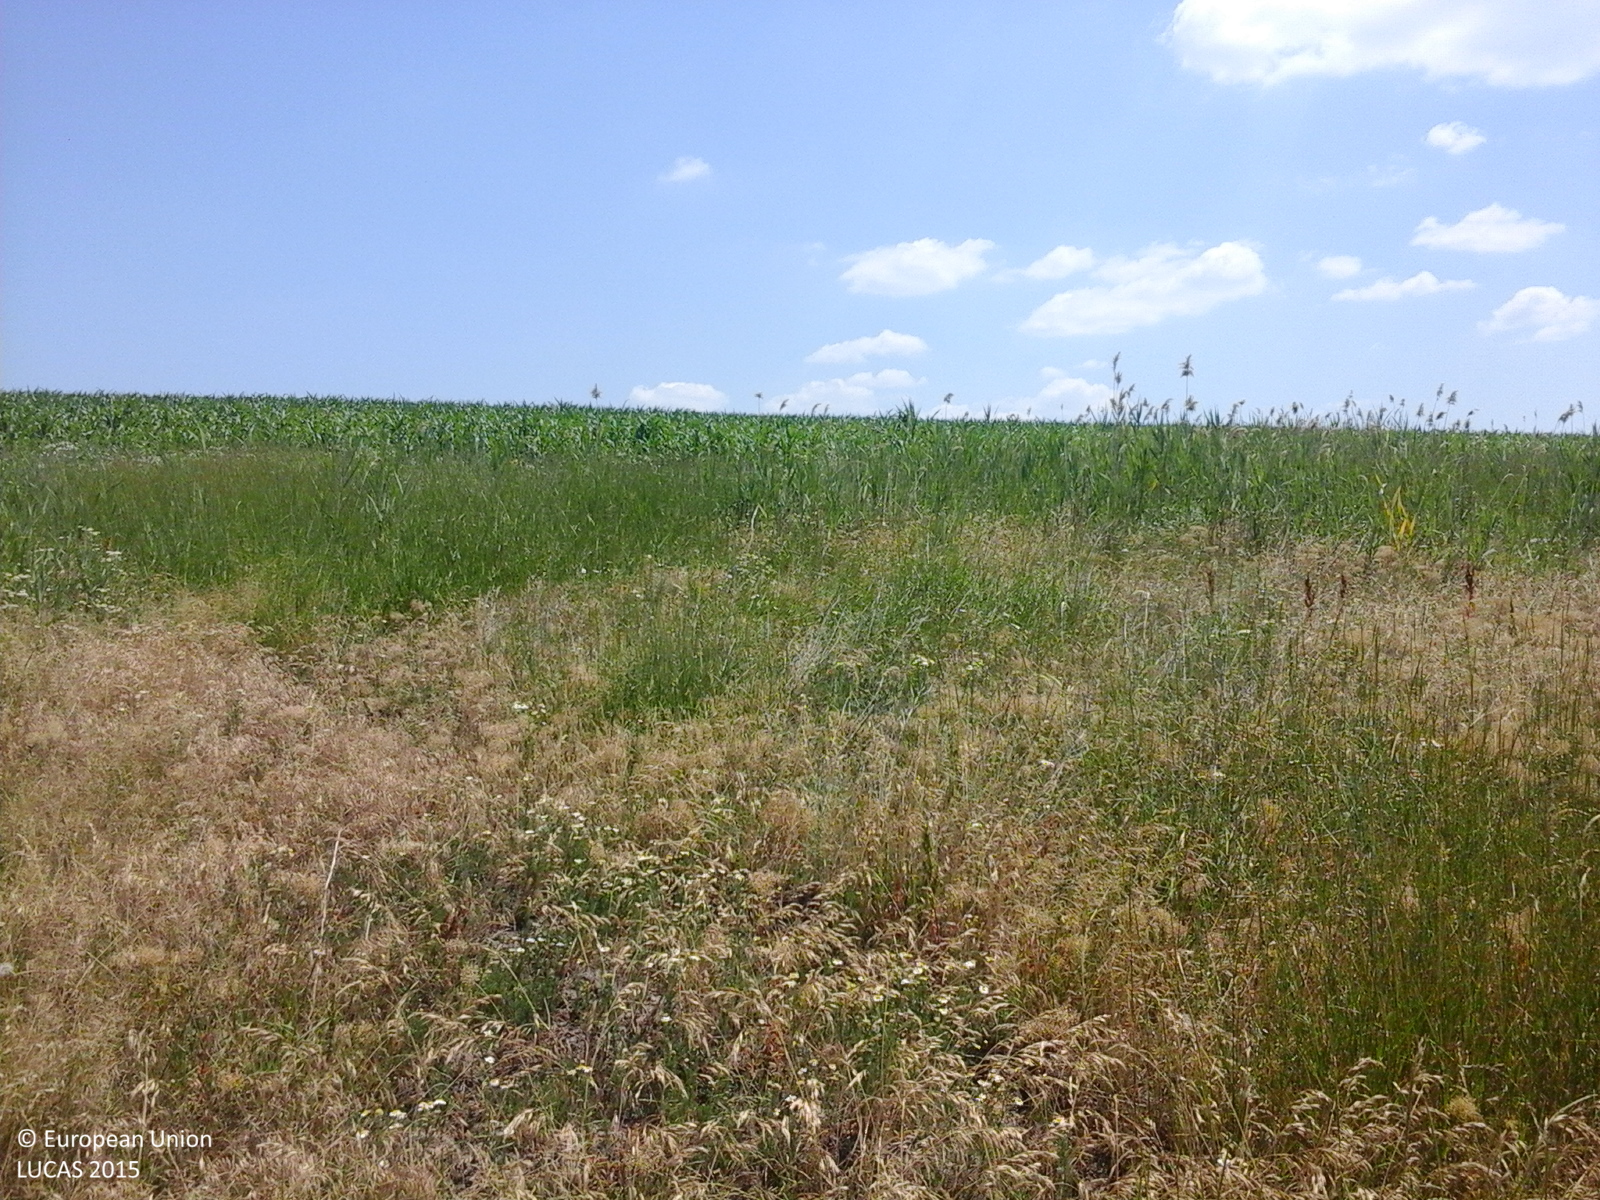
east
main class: Grassland
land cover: Grassland without tree/shrub cover
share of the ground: > 75 %
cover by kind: herbaceous plants 100 %
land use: Agriculture (excluding fallow land and kitchen gardens)
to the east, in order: Grassland without tree/shrub cover; Maize; Sunflower
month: June
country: RO
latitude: 47.2383
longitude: 27.3507
